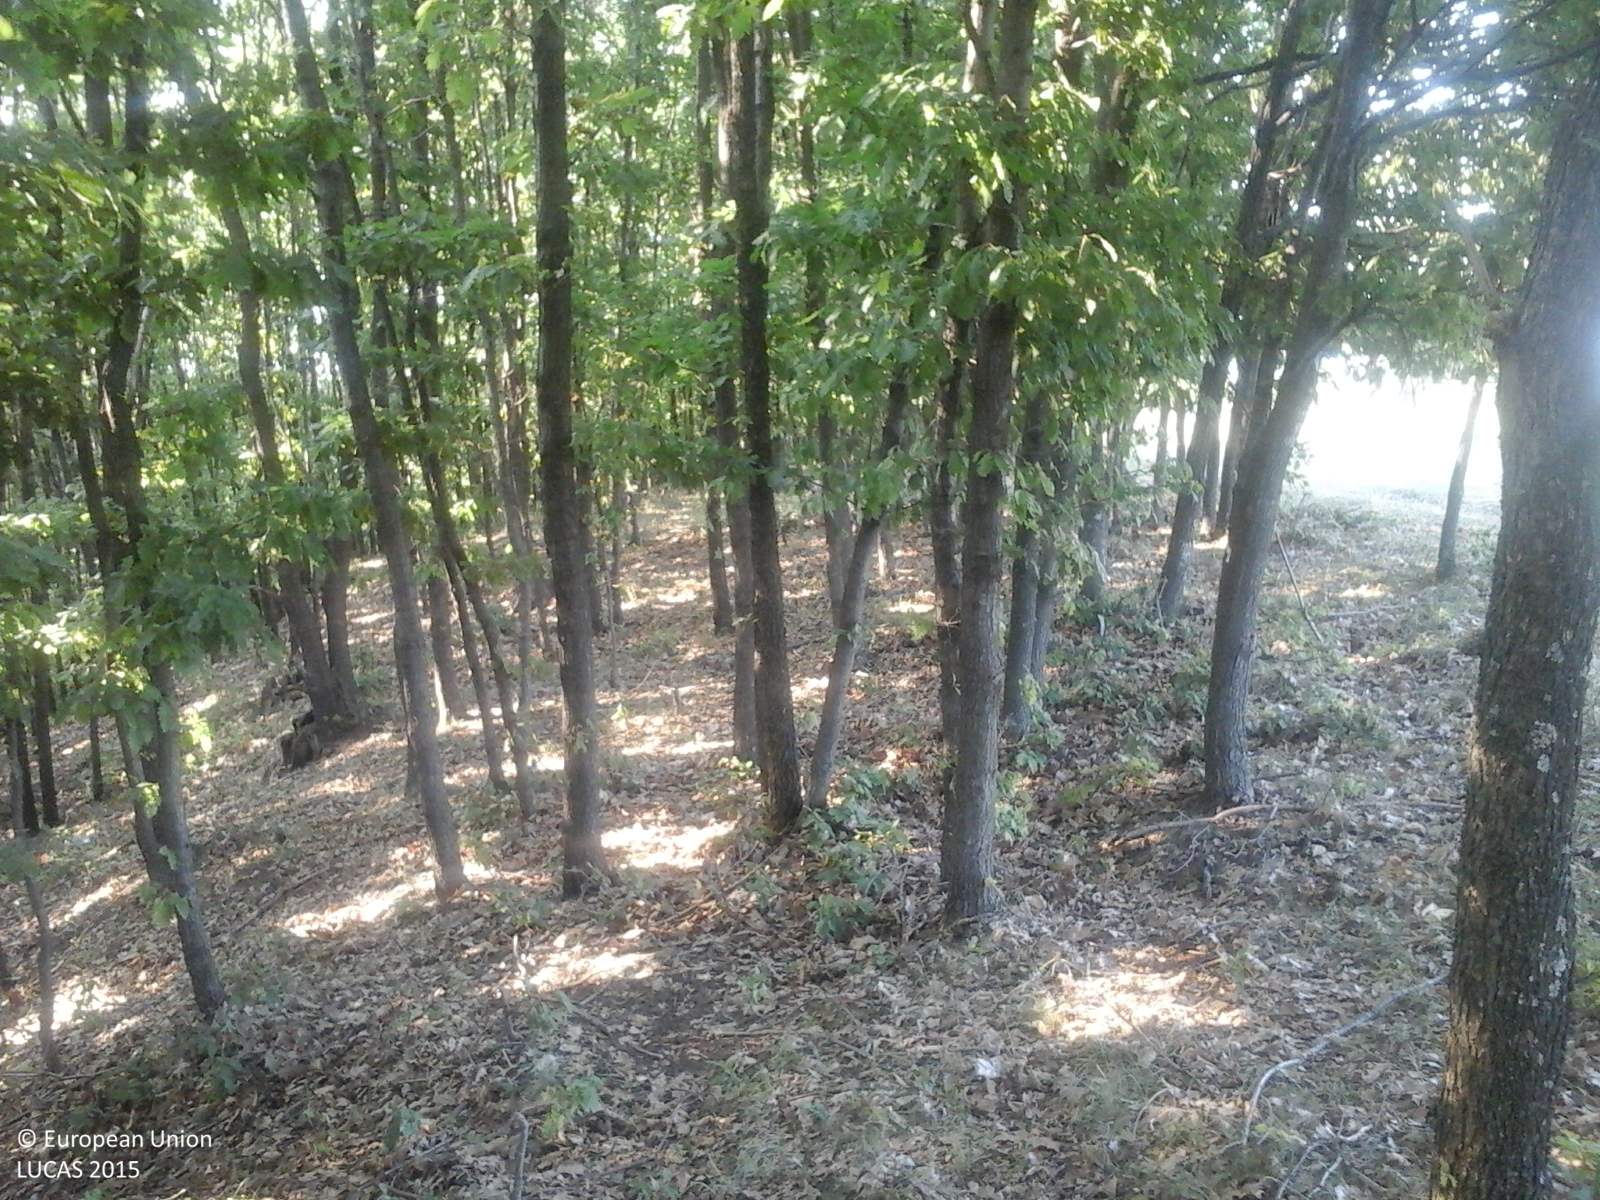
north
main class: Woodland
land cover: Broadleaved woodland
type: acidophilous oak and oak-birch forest
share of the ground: > 75 %
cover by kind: broadleaved forest trees 100 %
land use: Forestry
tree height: > 5 m
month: July
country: RO
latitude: 44.9209
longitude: 24.6076
